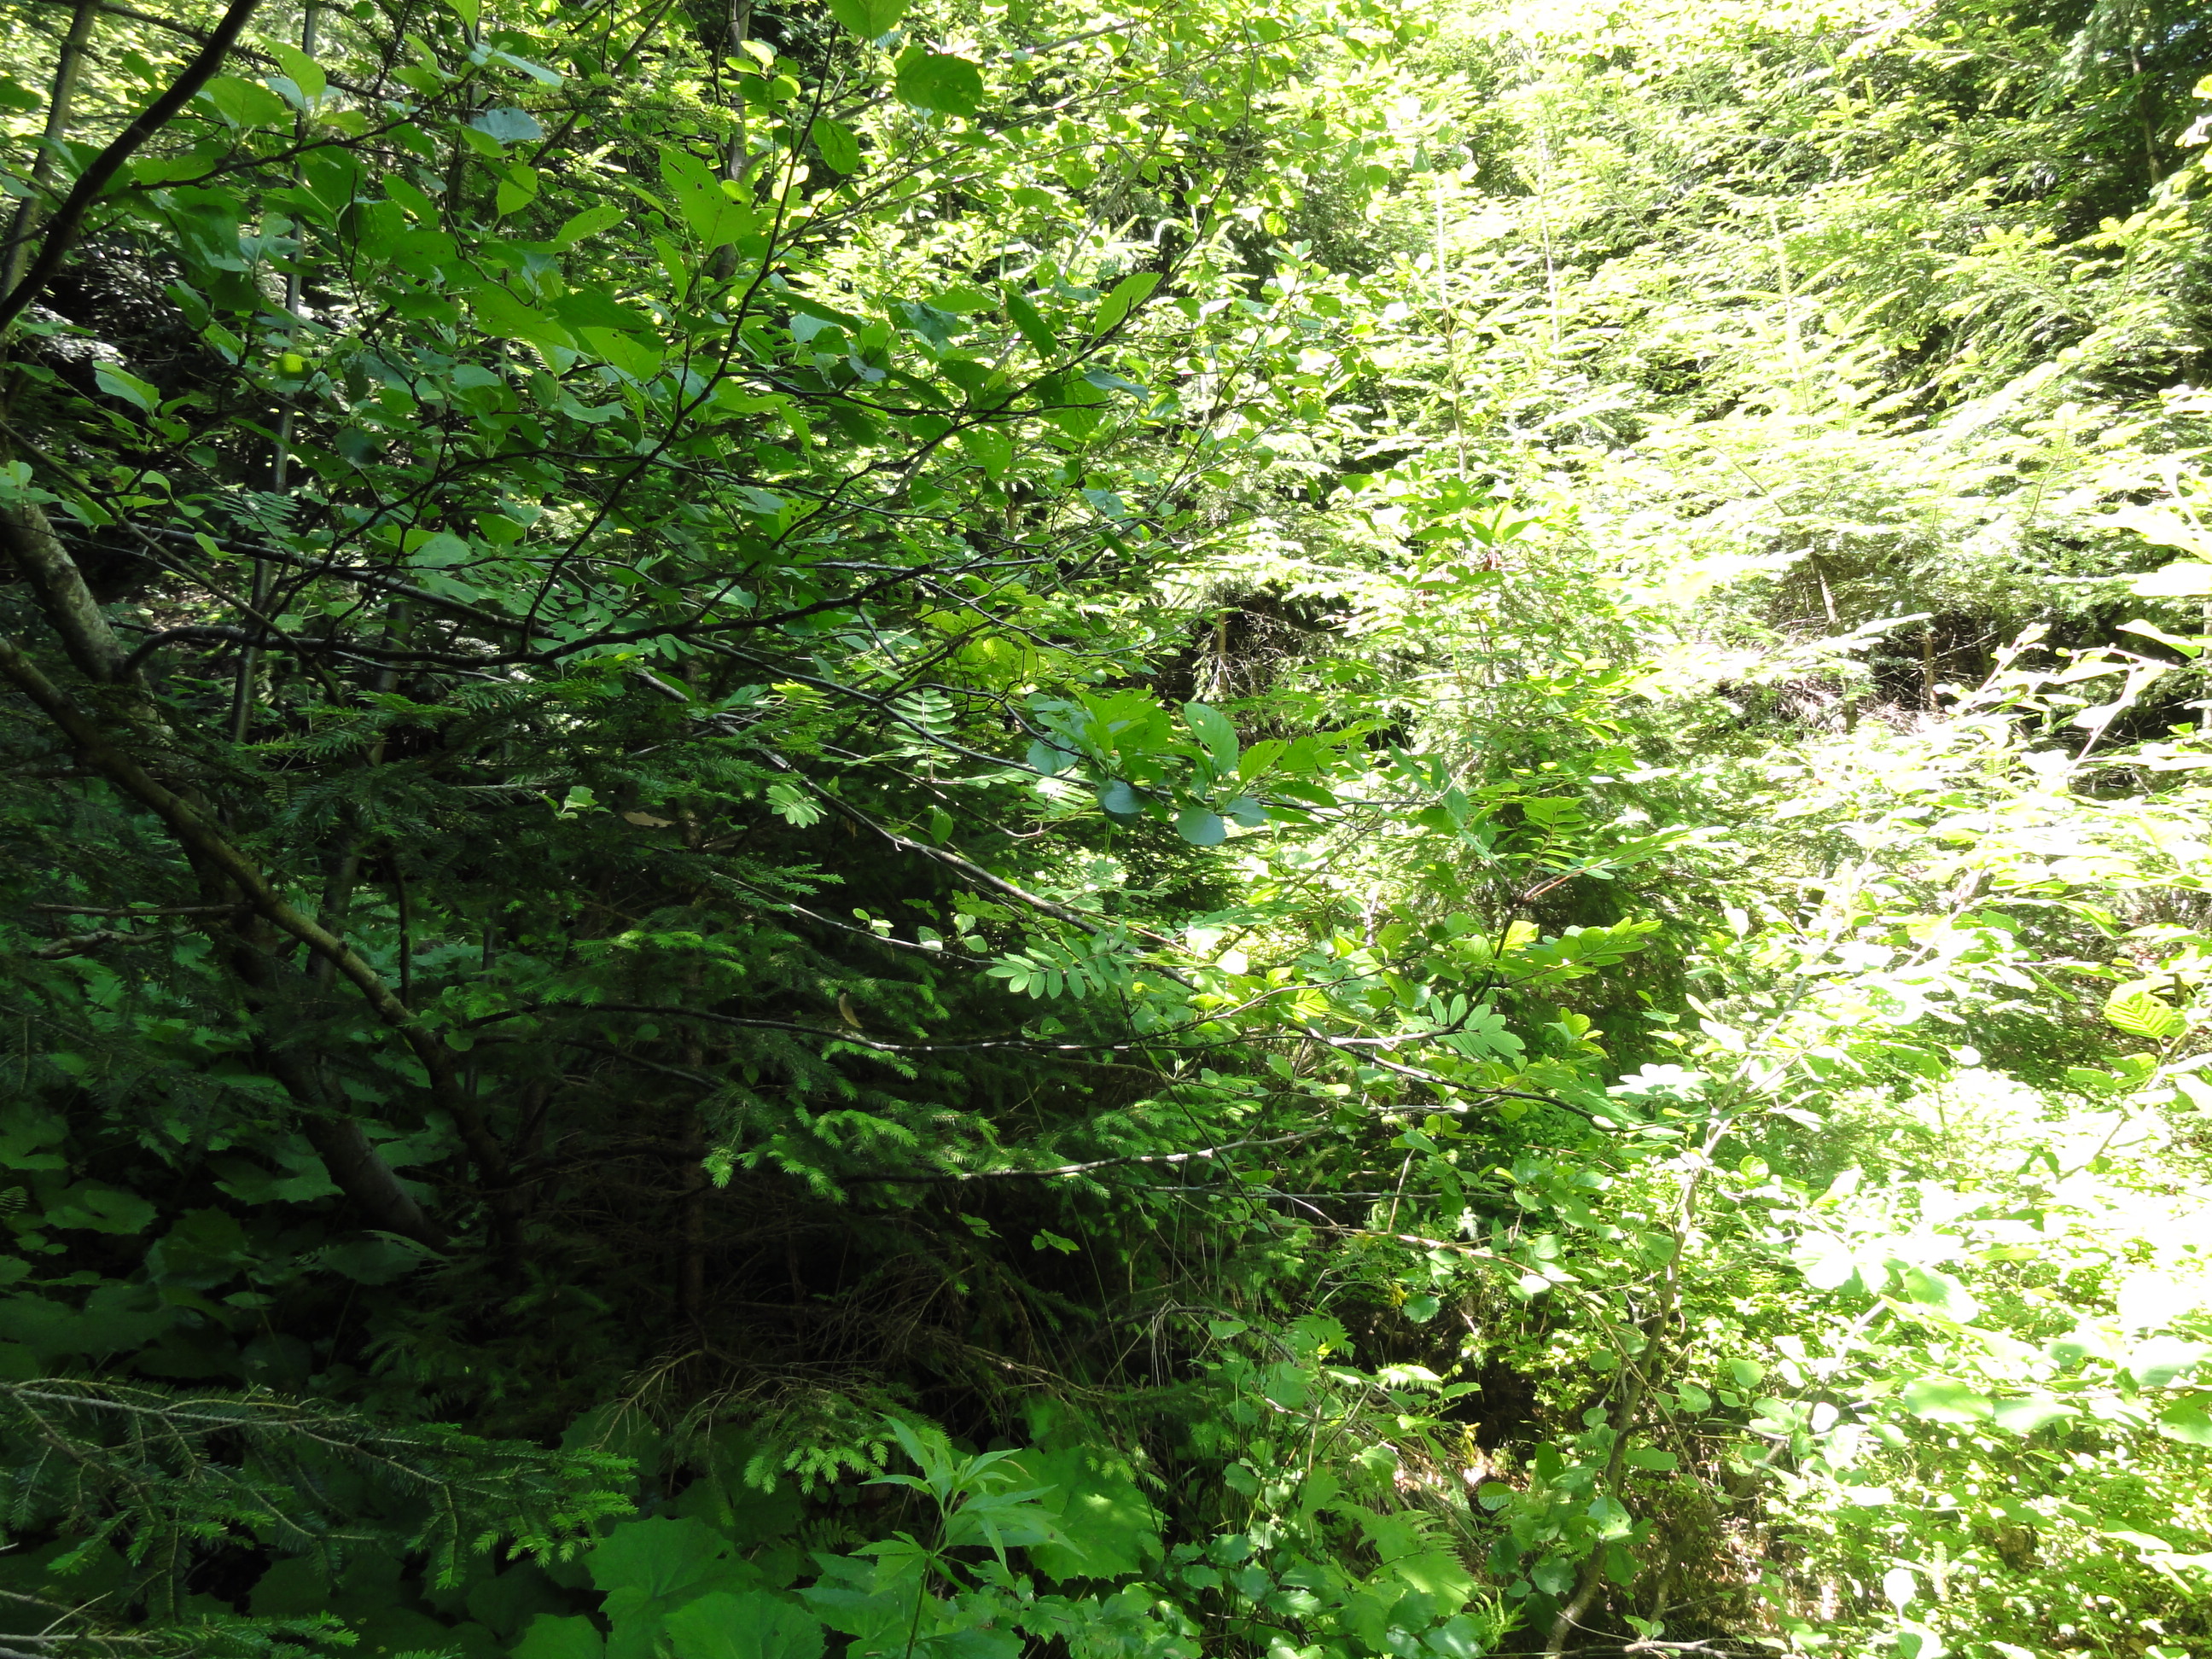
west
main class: Woodland
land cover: Spruce dominated mixed woodland
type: hemiboreal forest and nemoral coniferous forest and mixed broadleaved-coniferous forest
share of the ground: > 75 %
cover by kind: broadleaved forest trees 50 %, coniferous forest trees 40 %, shrubs 5 %, unconsolidated bare surface 5 %
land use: Forestry
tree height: > 5 m
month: June
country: SI
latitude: 46.1964
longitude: 15.0381
